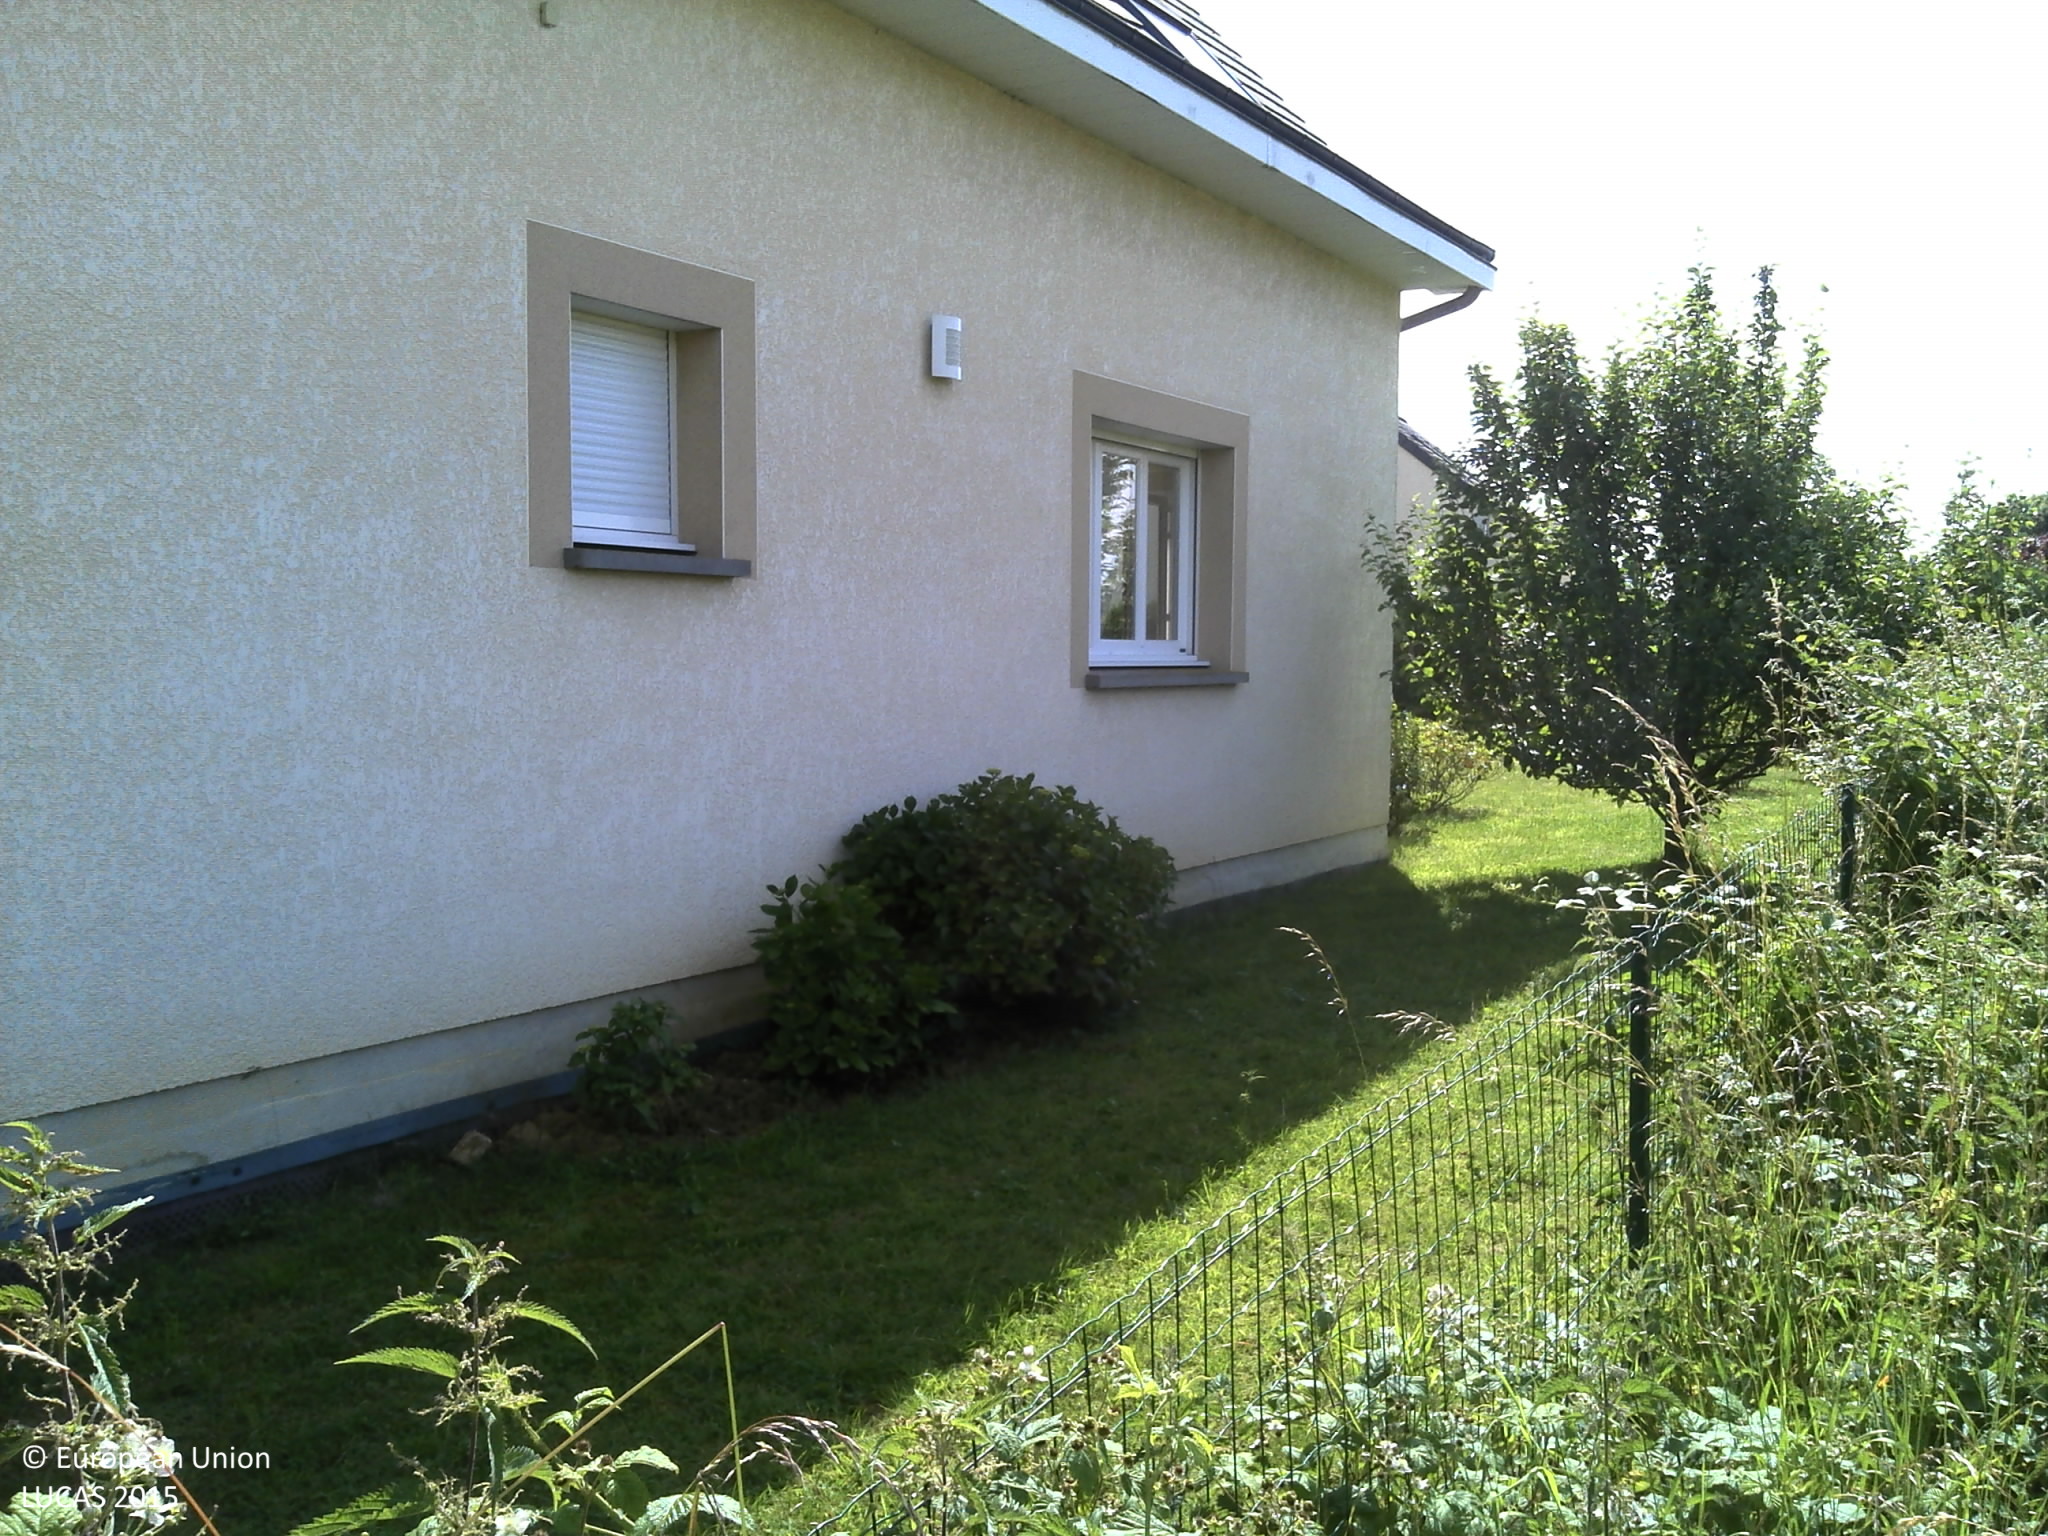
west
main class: Grassland
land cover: Grassland without tree/shrub cover
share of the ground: > 75 %
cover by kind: herbaceous plants 100 %
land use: Residential
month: June
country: FR
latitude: 49.7422
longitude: 4.8209
